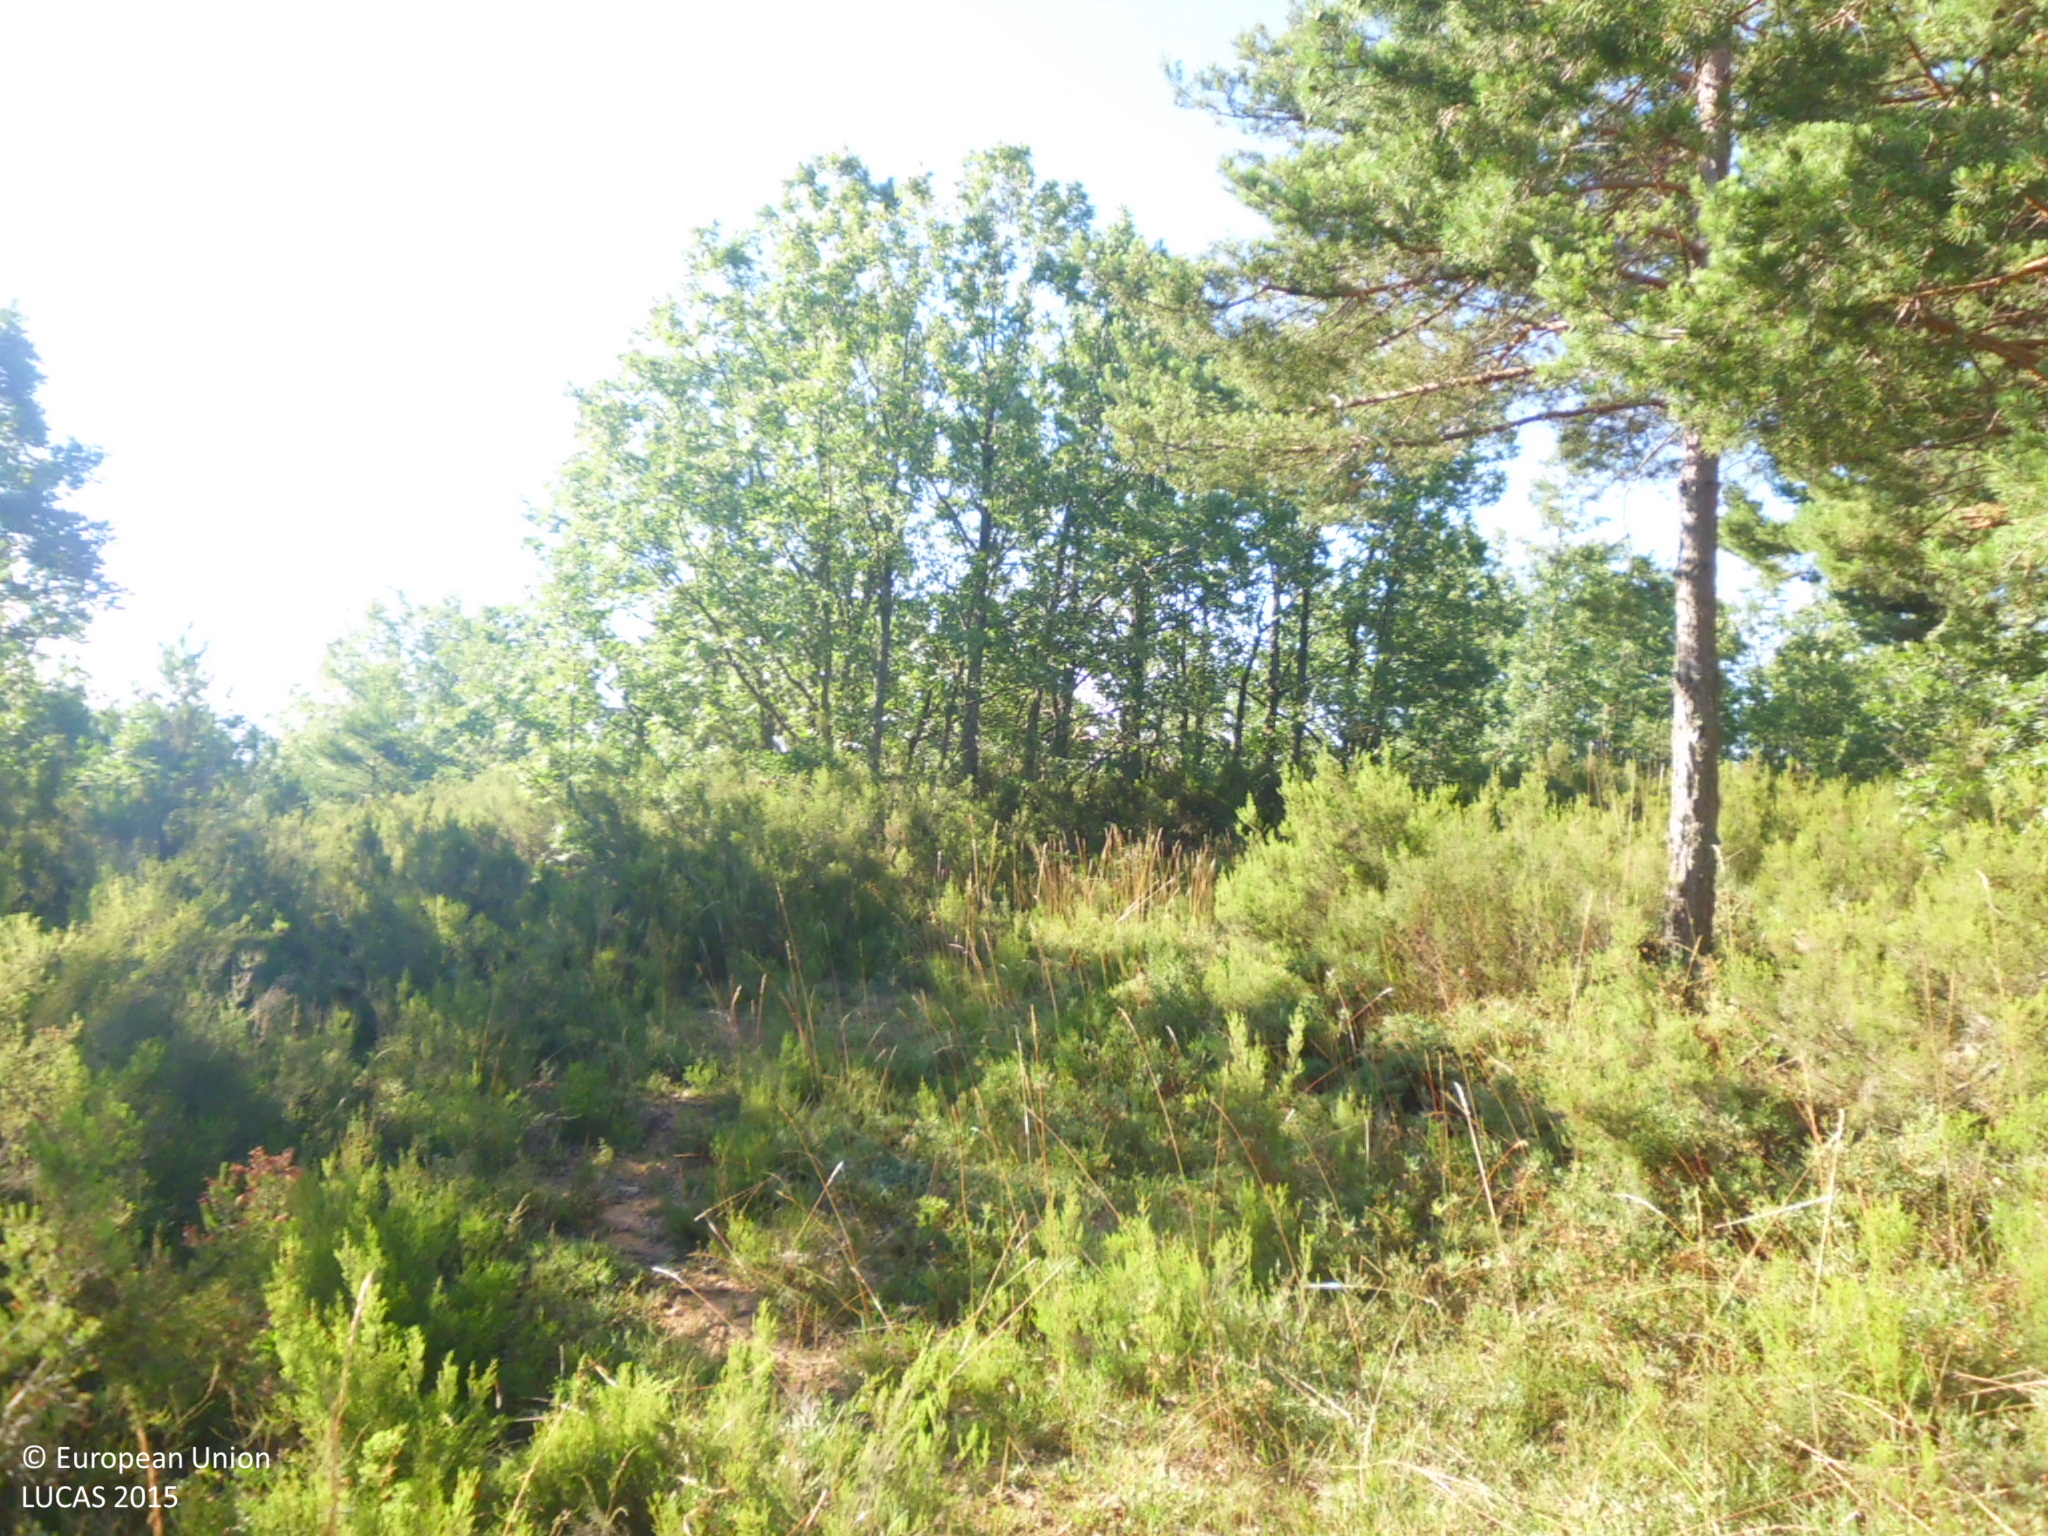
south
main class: Woodland
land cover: Broadleaved woodland
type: acidophilous oak and oak-birch forest
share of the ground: 50 - 75 %
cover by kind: broadleaved forest trees 50 %, shrubs 50 %
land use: Semi-natural and natural areas not in use
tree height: > 5 m
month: June
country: ES
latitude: 42.6793
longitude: -5.0366
